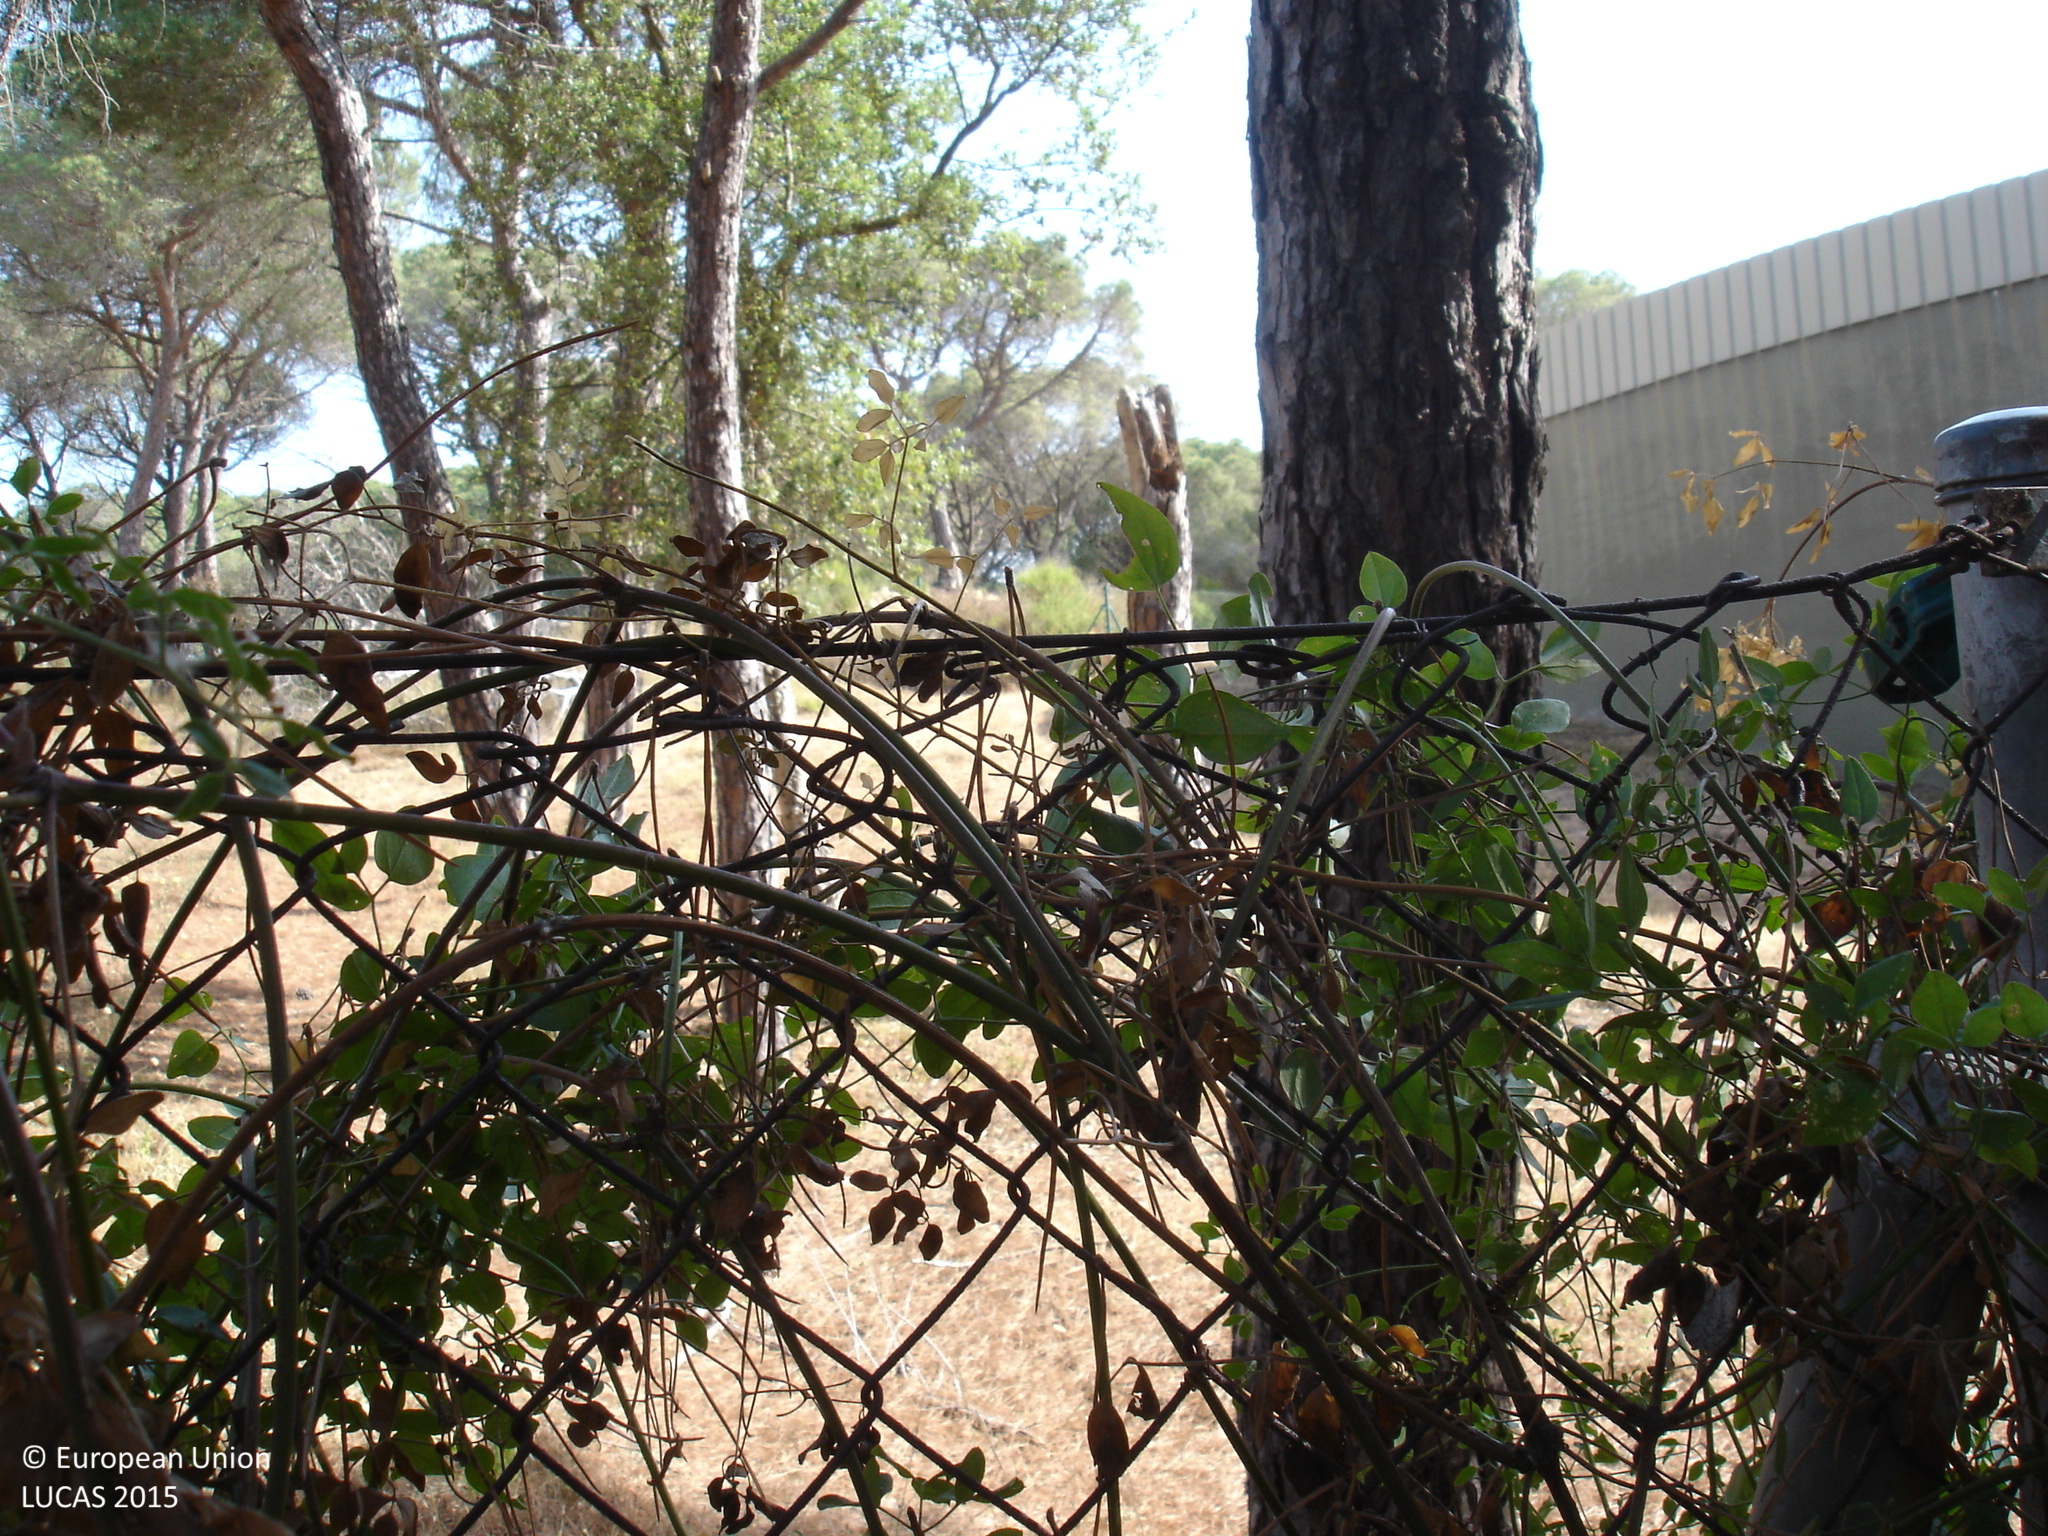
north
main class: Woodland
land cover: Pine dominated coniferous woodland
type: coniferous forest of the mediterranean region
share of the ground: 50 - 75 %
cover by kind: coniferous forest trees 70 %, herbaceous plants 25 %, broadleaved forest trees 5 %
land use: Forestry
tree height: > 5 m
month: July
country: ES
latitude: 41.7971
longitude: 3.0247
